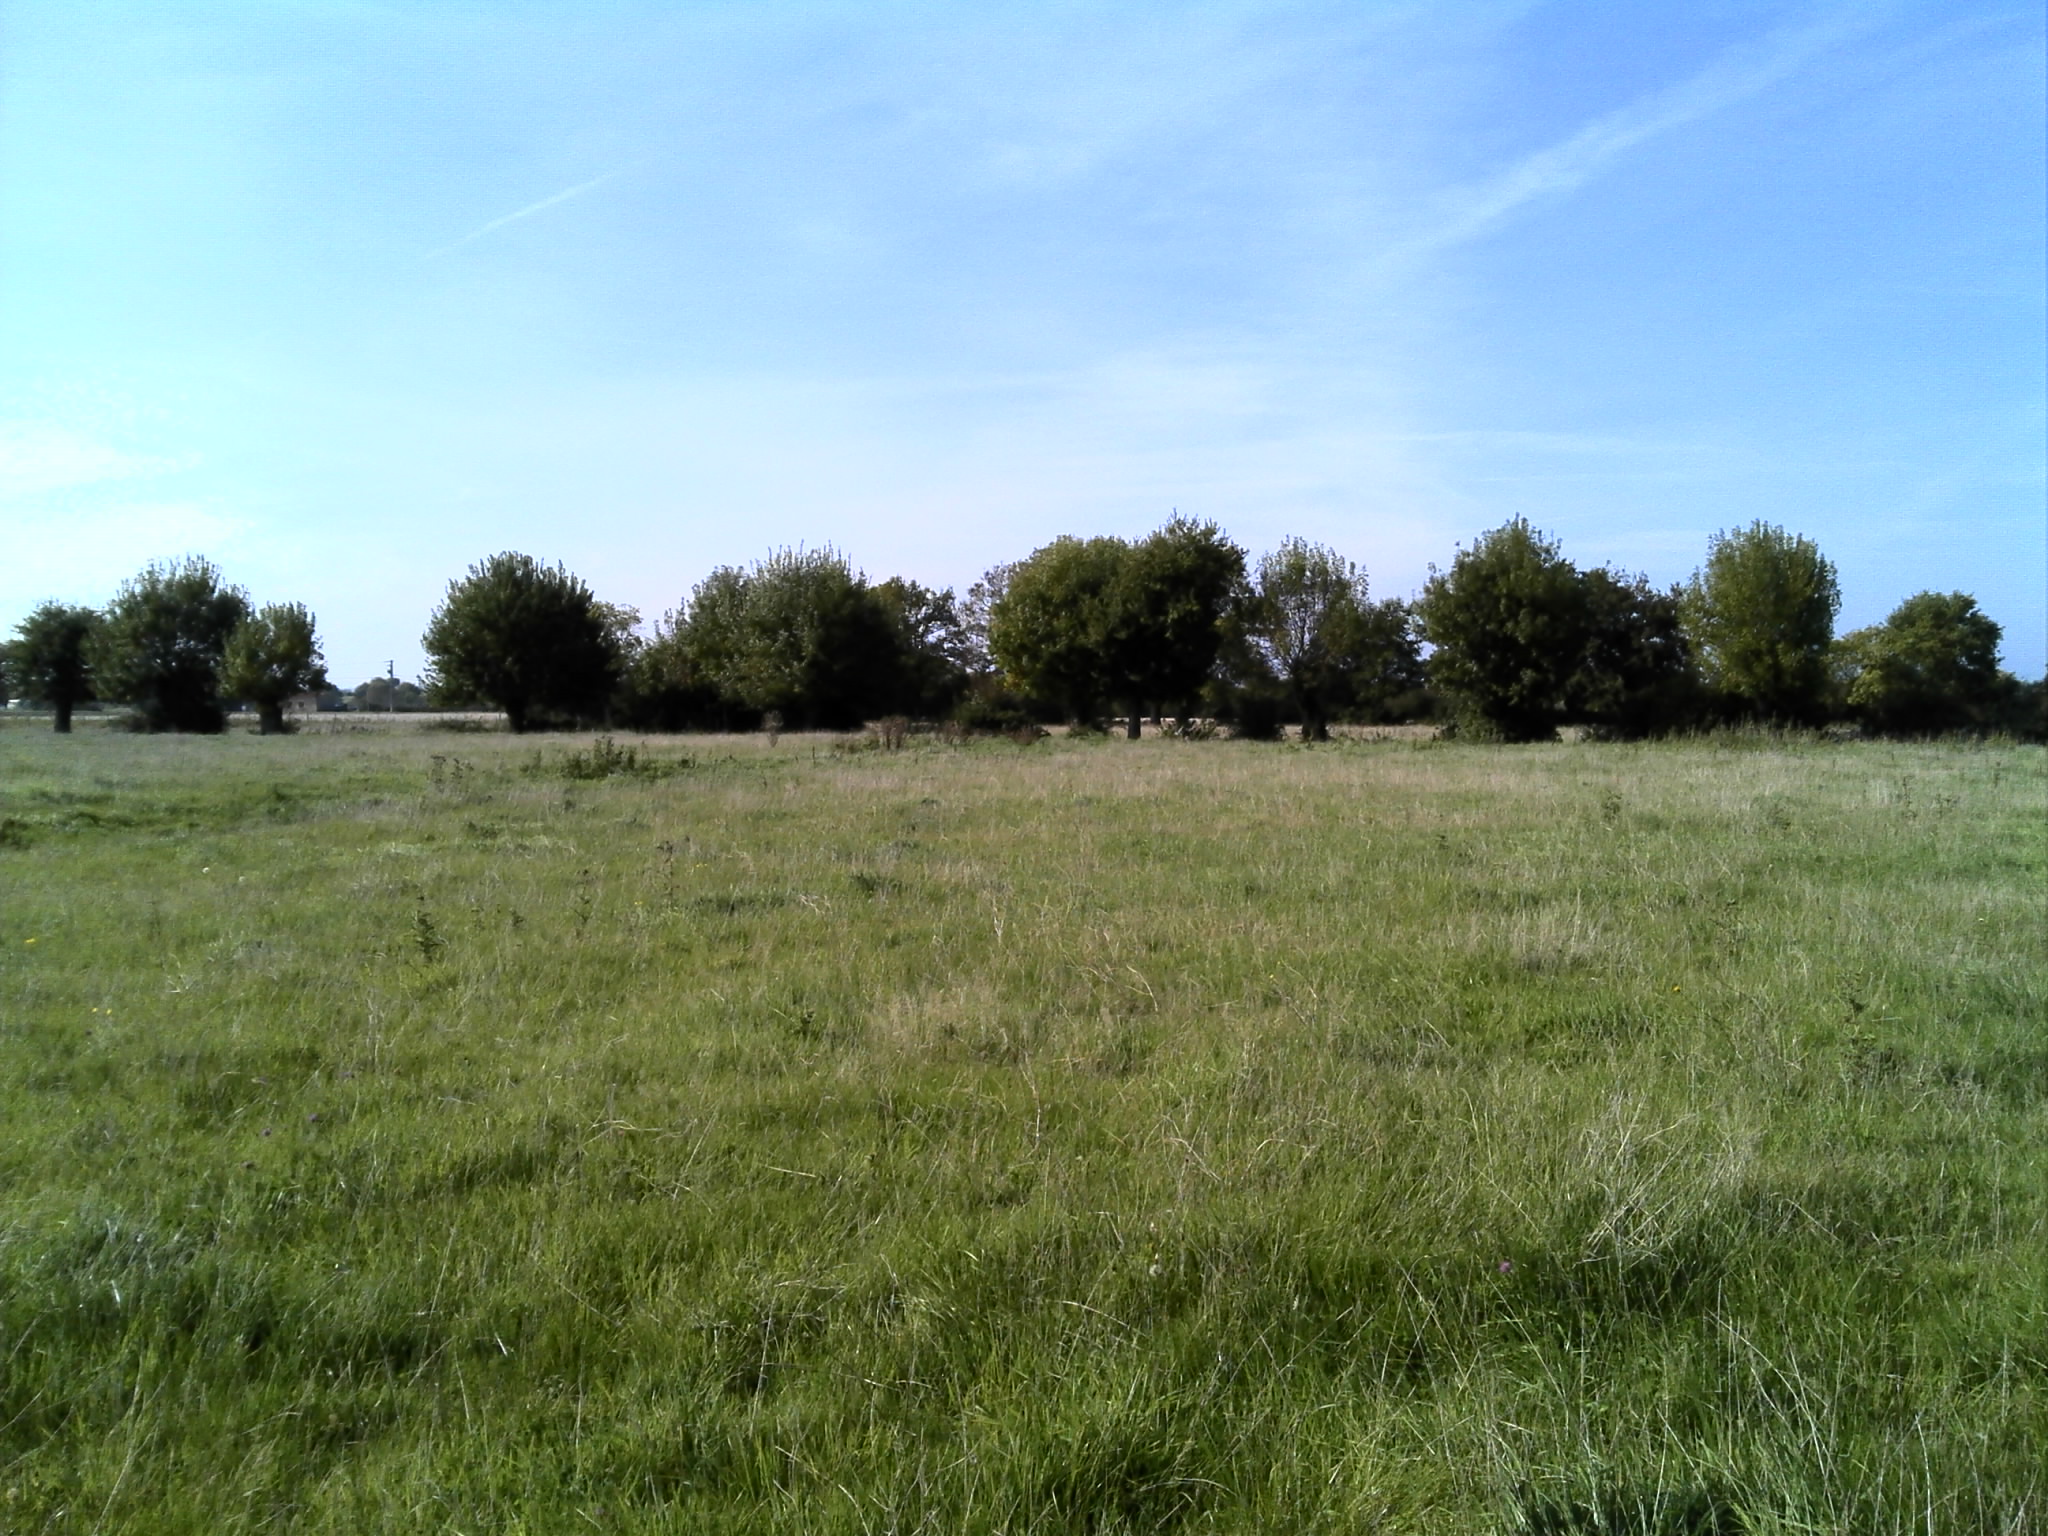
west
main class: Grassland
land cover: Grassland without tree/shrub cover
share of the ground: > 75 %
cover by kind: herbaceous plants 100 %
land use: Agriculture (excluding fallow land and kitchen gardens)
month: October
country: FR
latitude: 47.3165
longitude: -1.2707
